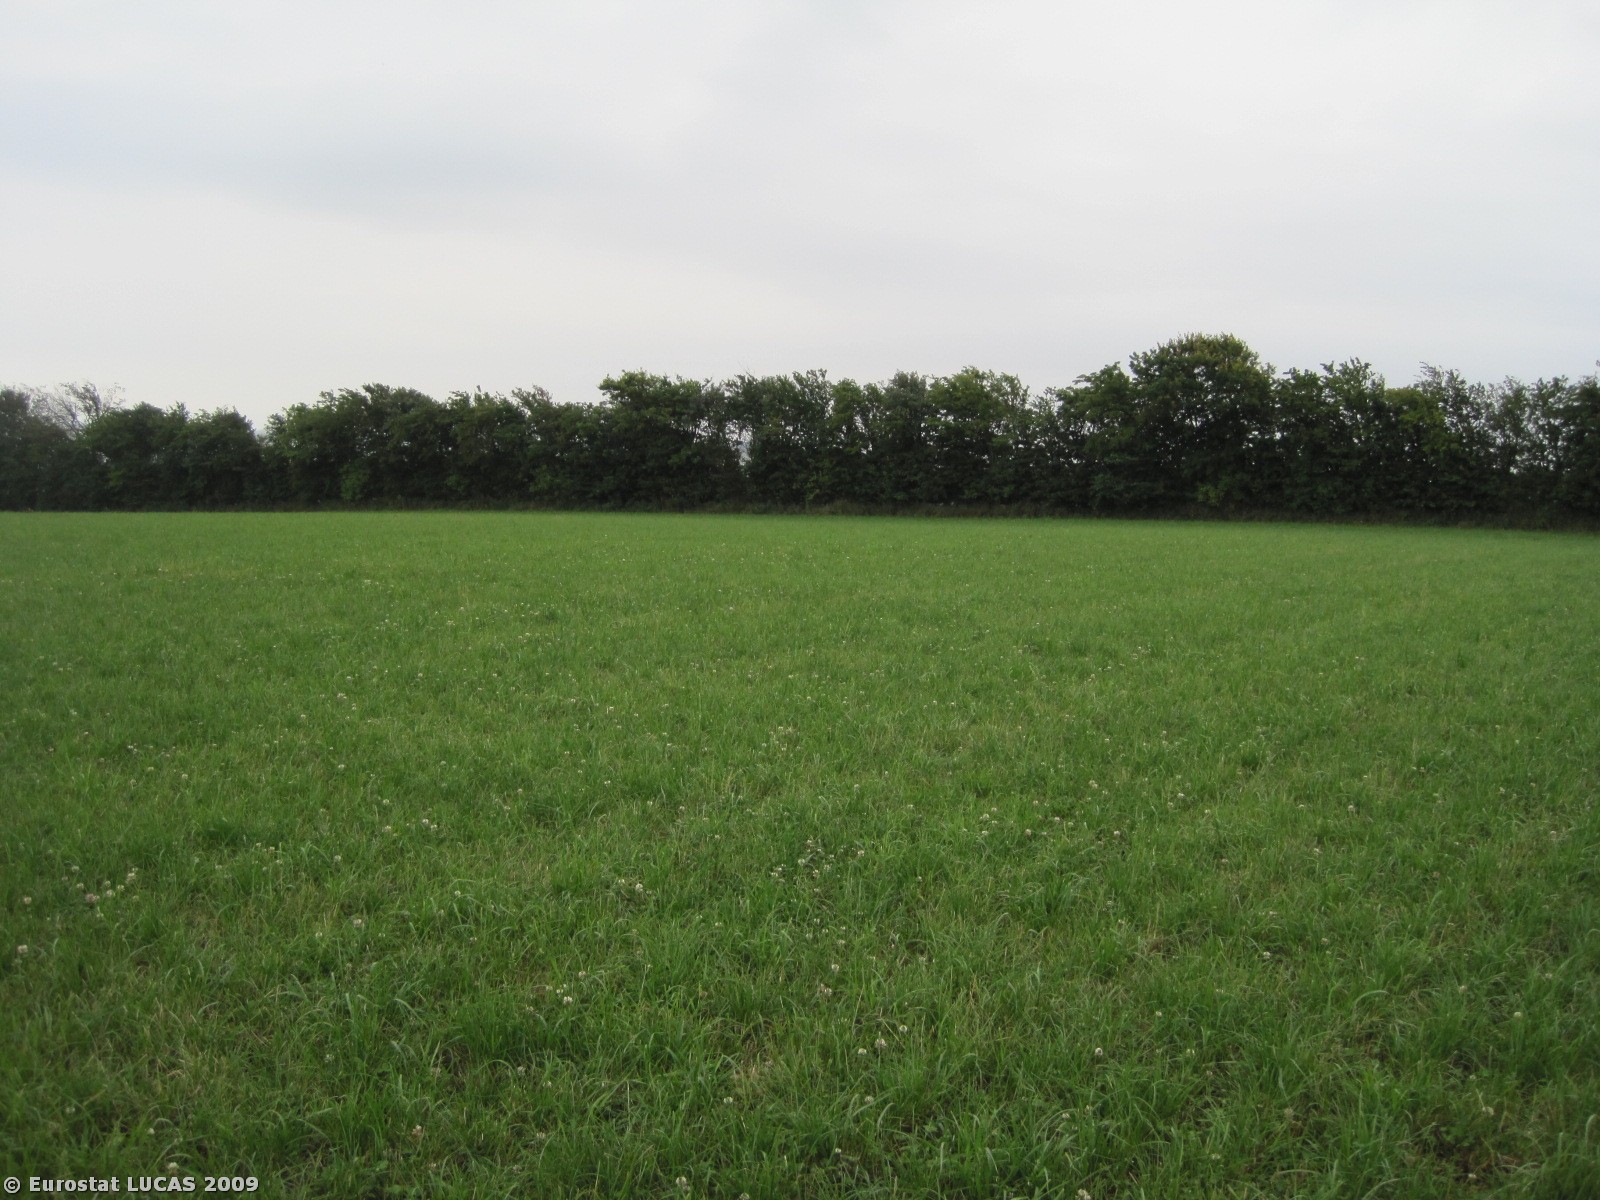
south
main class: Grassland
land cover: Grassland without tree/shrub cover
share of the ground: > 75 %
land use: Agriculture (excluding fallow land and kitchen gardens)
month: July
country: DK
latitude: 56.8271
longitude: 8.5763
